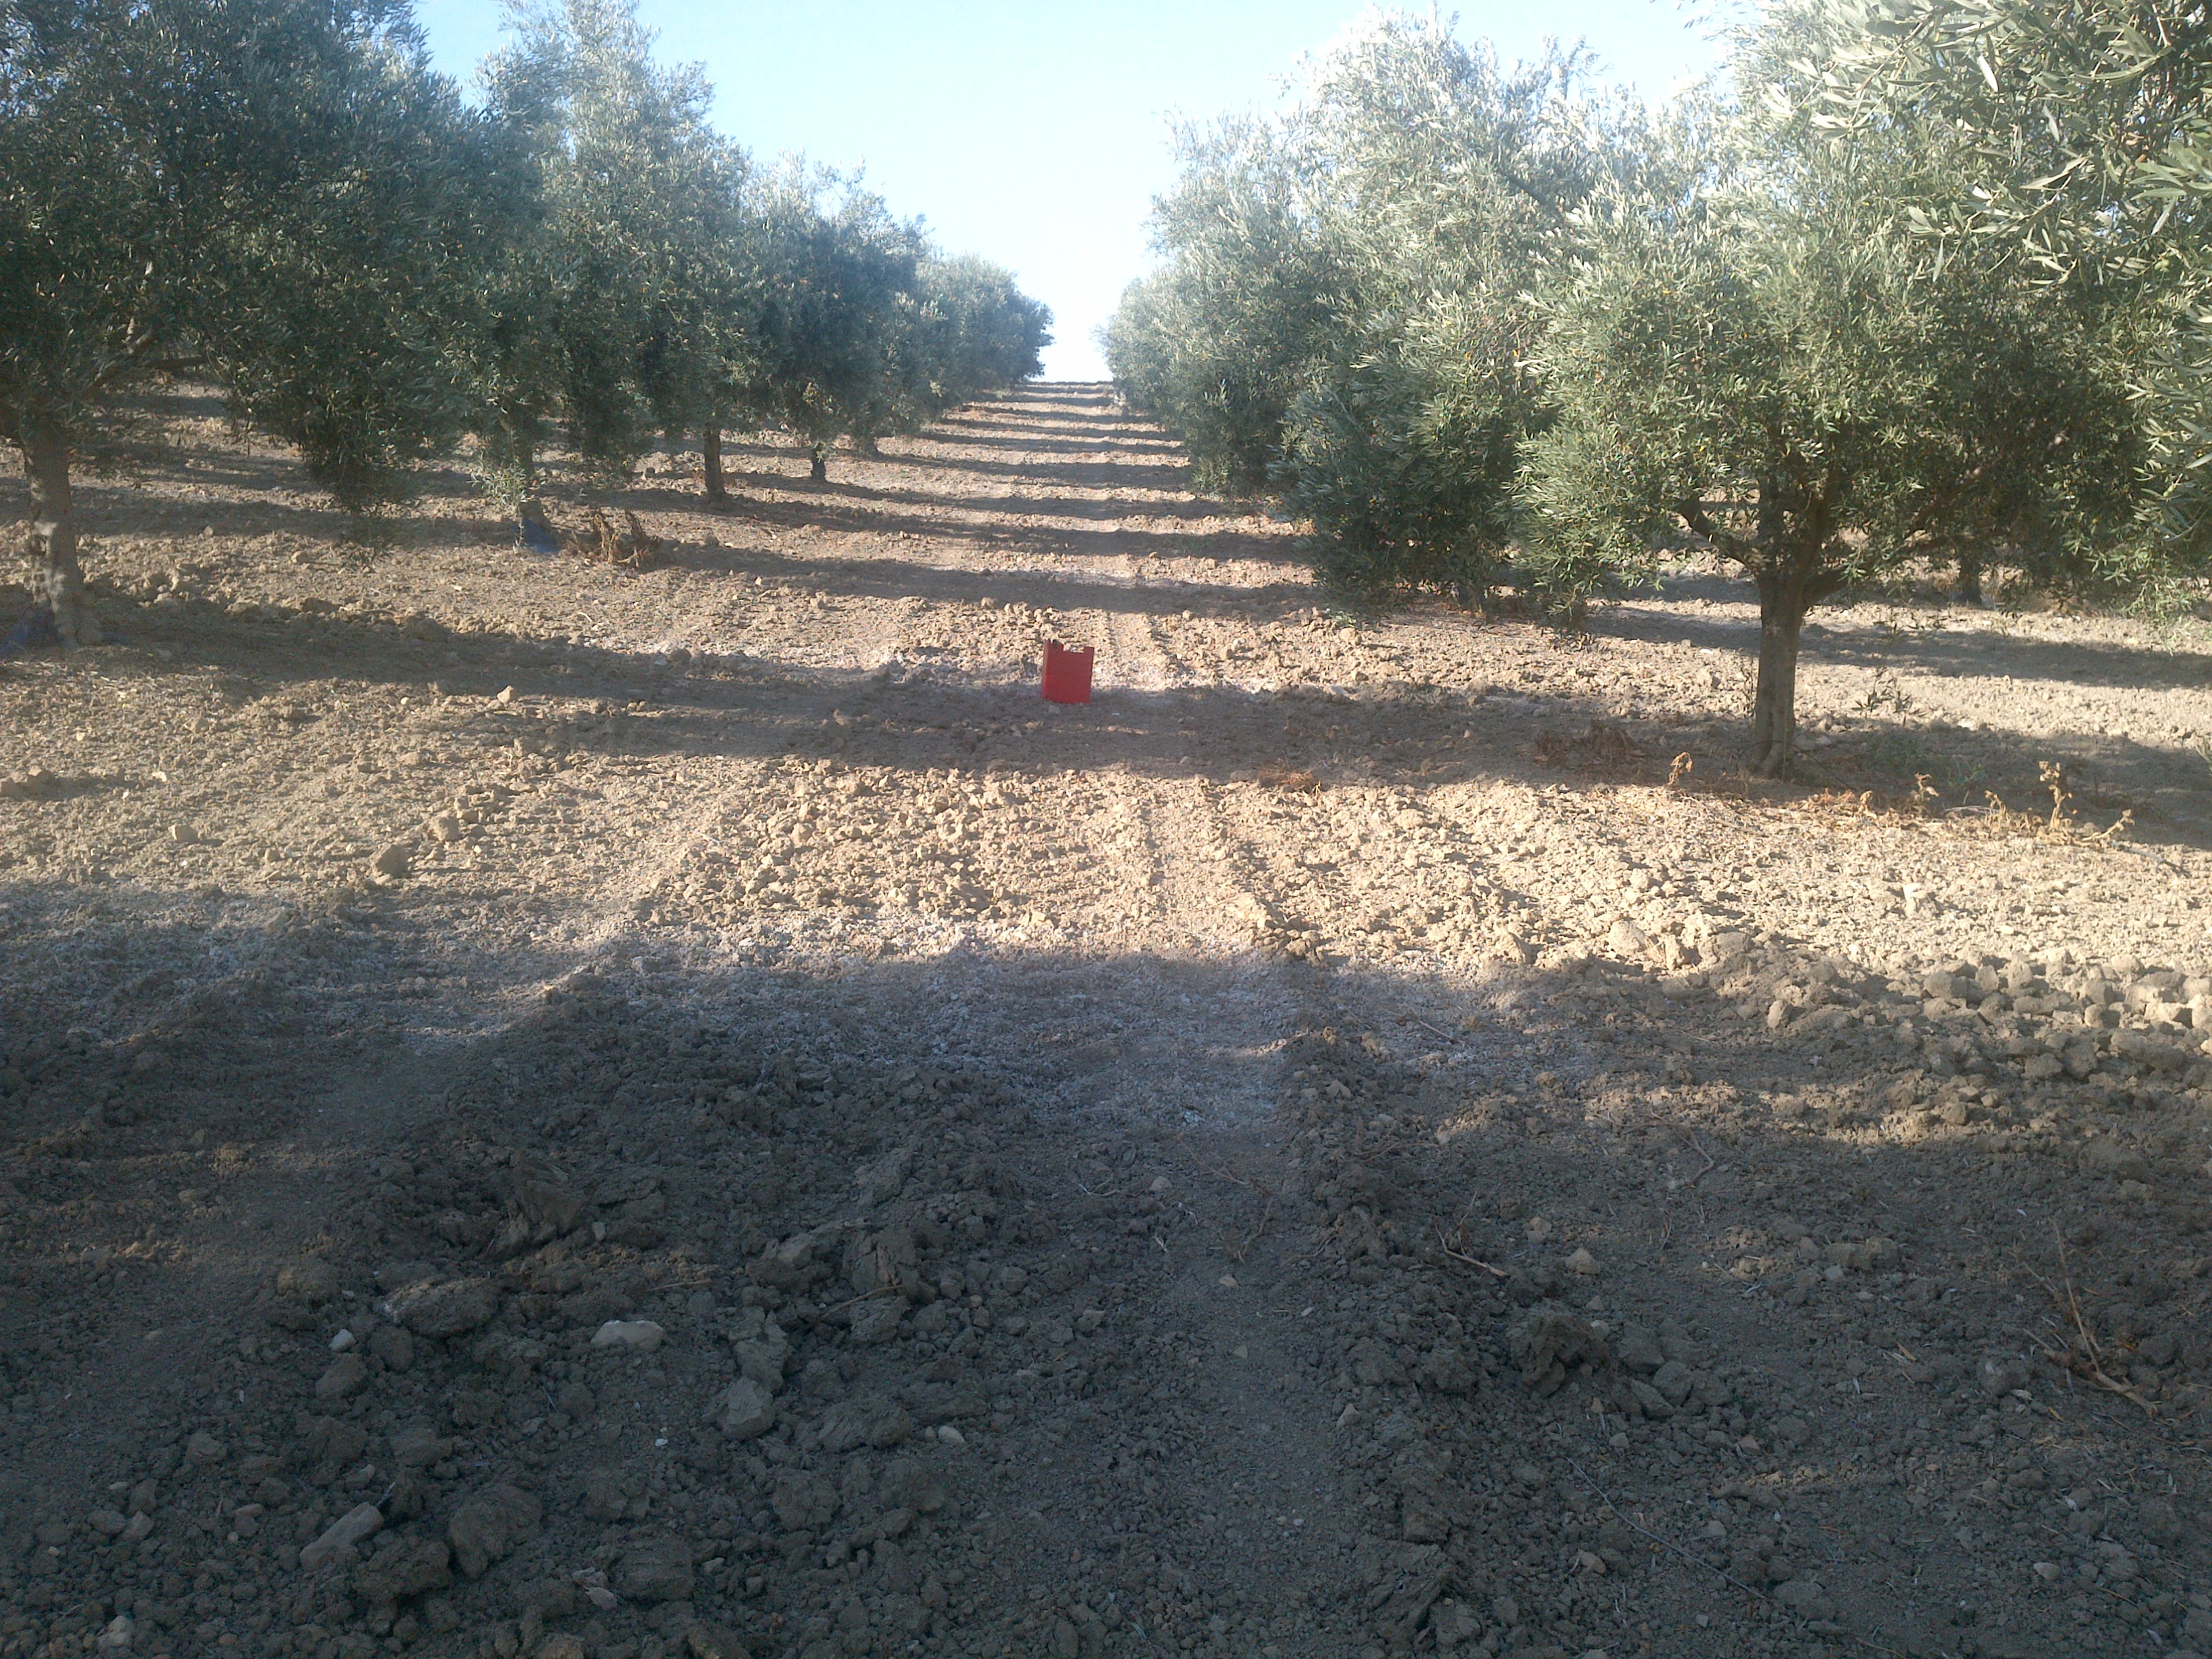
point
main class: Cropland
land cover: Olive groves
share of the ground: 50 - 75 %
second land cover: Other bare soil
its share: > 75 %
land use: Agriculture (excluding fallow land and kitchen gardens)
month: June
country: ES
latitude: 37.5498
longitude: -4.8489
